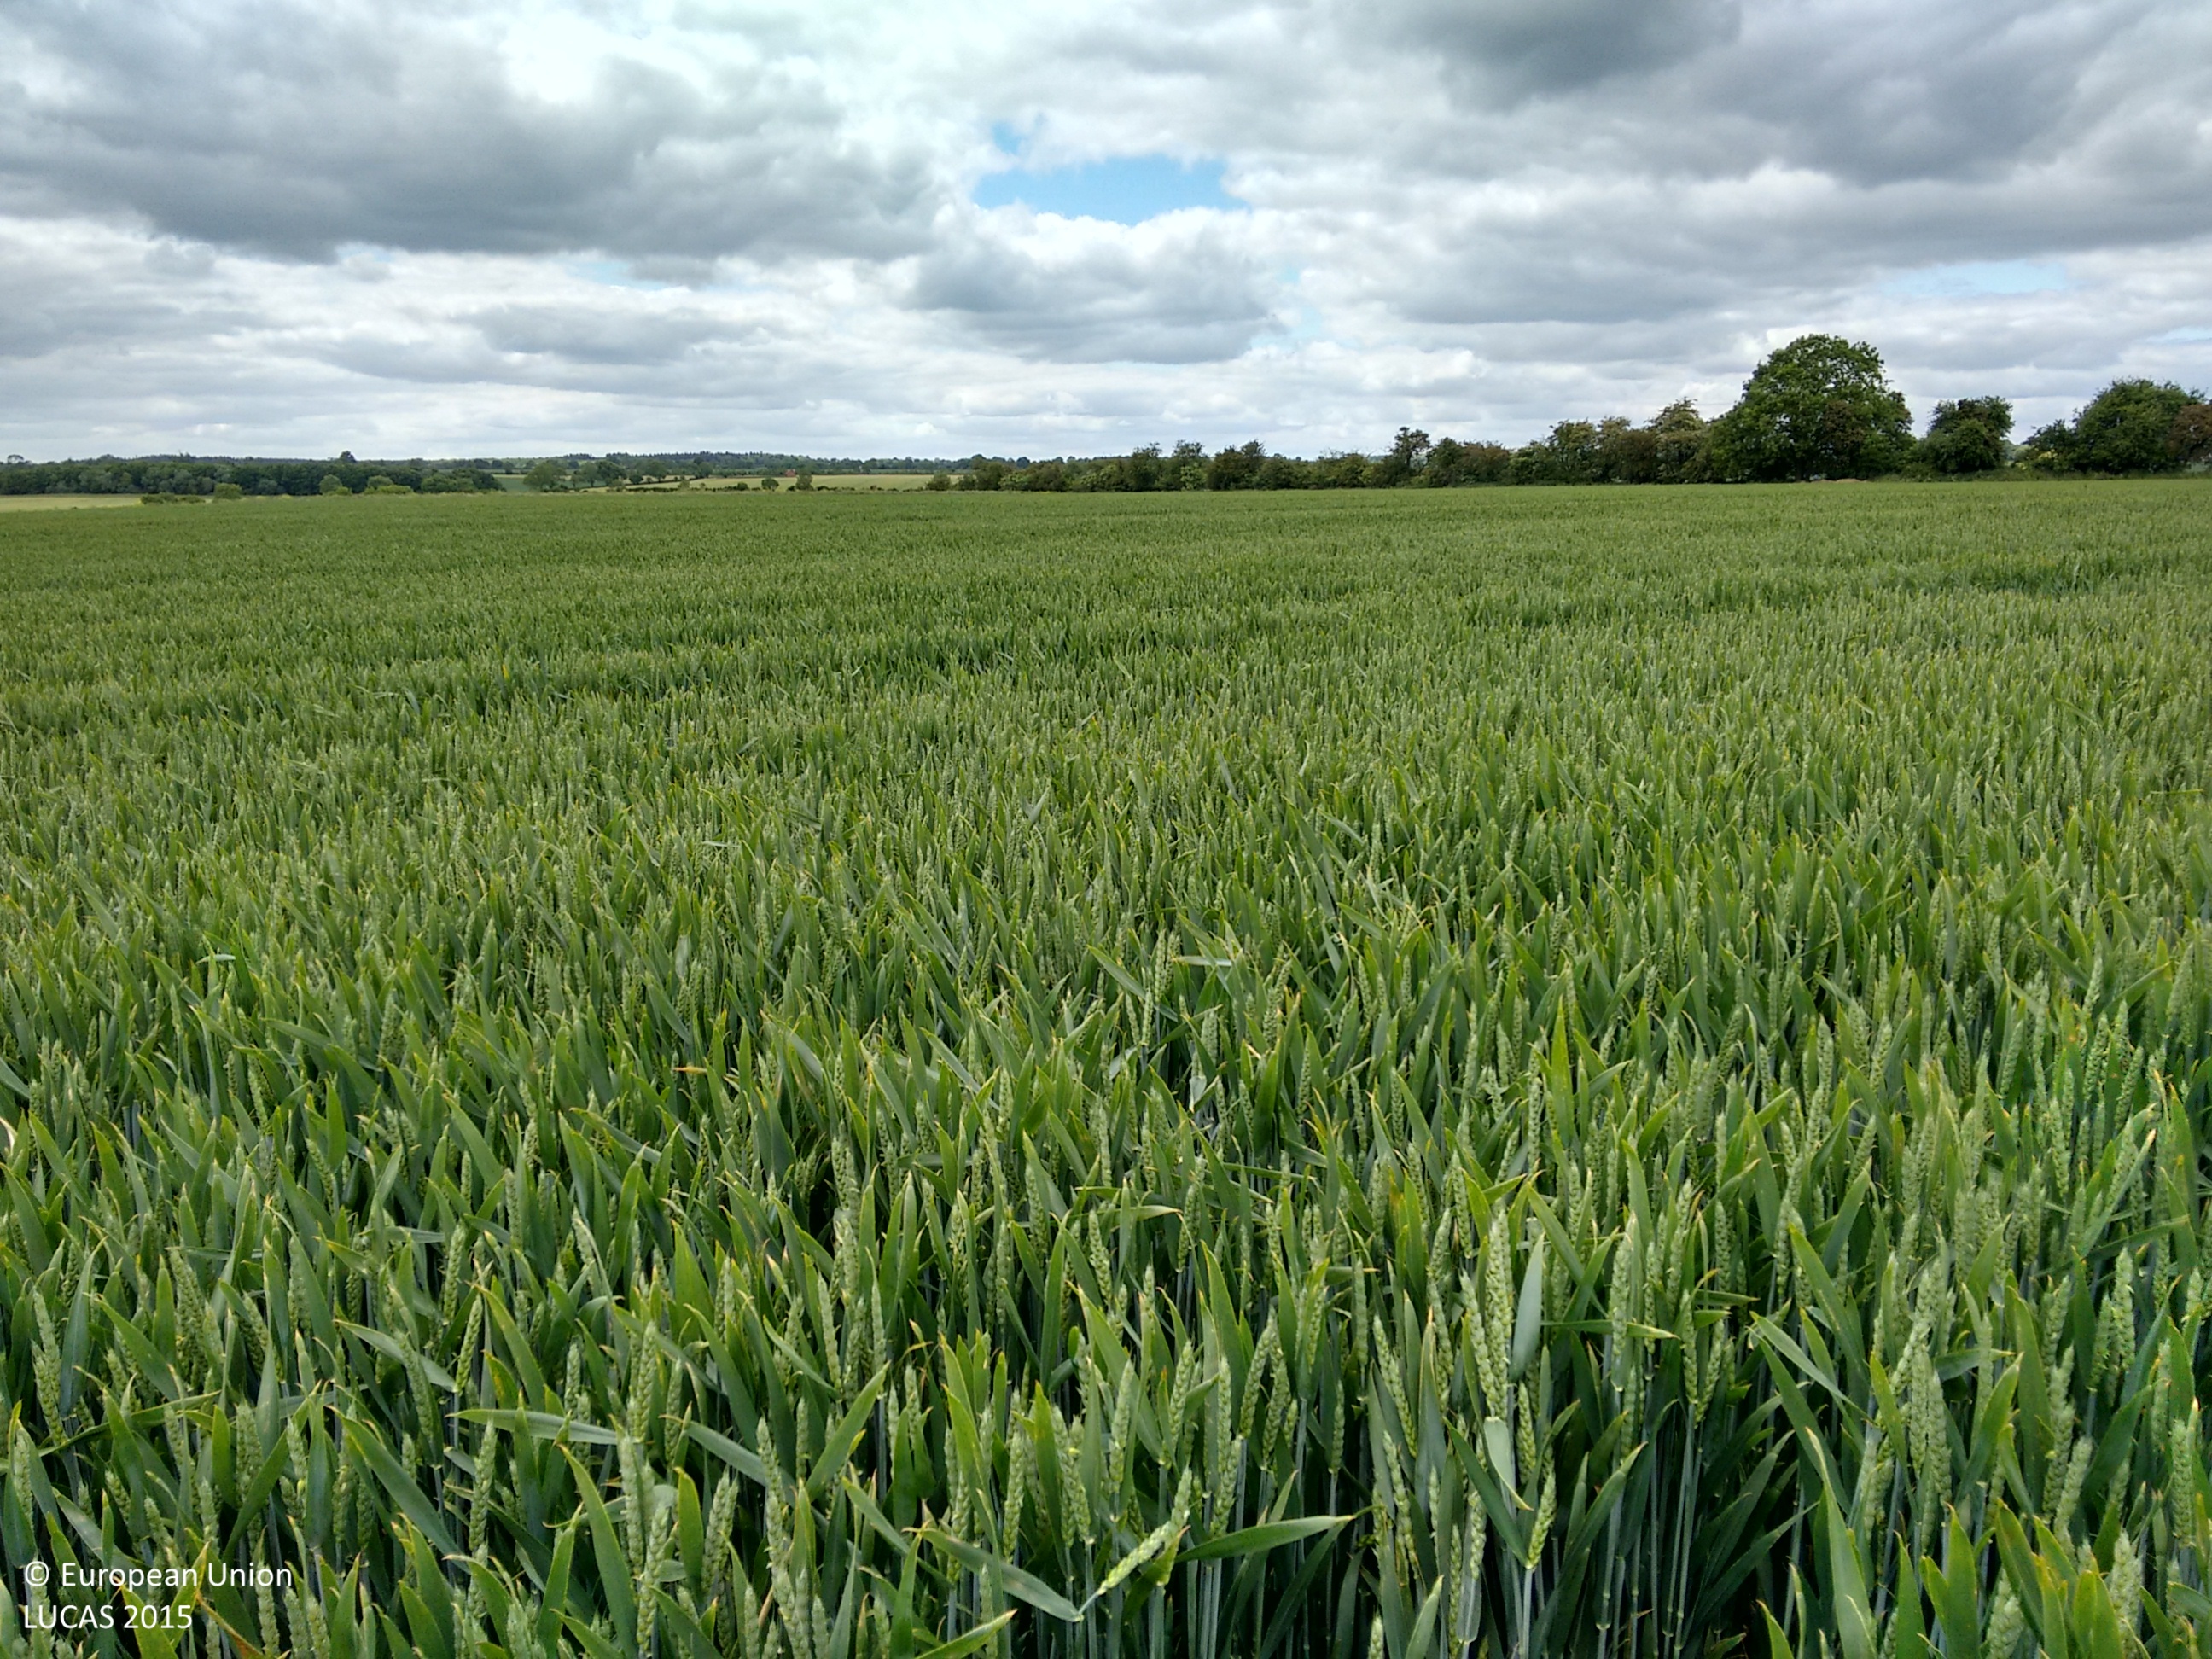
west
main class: Cropland
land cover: Common wheat
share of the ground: > 75 %
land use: Agriculture (excluding fallow land and kitchen gardens)
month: June
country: GB
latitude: 52.8732
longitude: -0.4821
